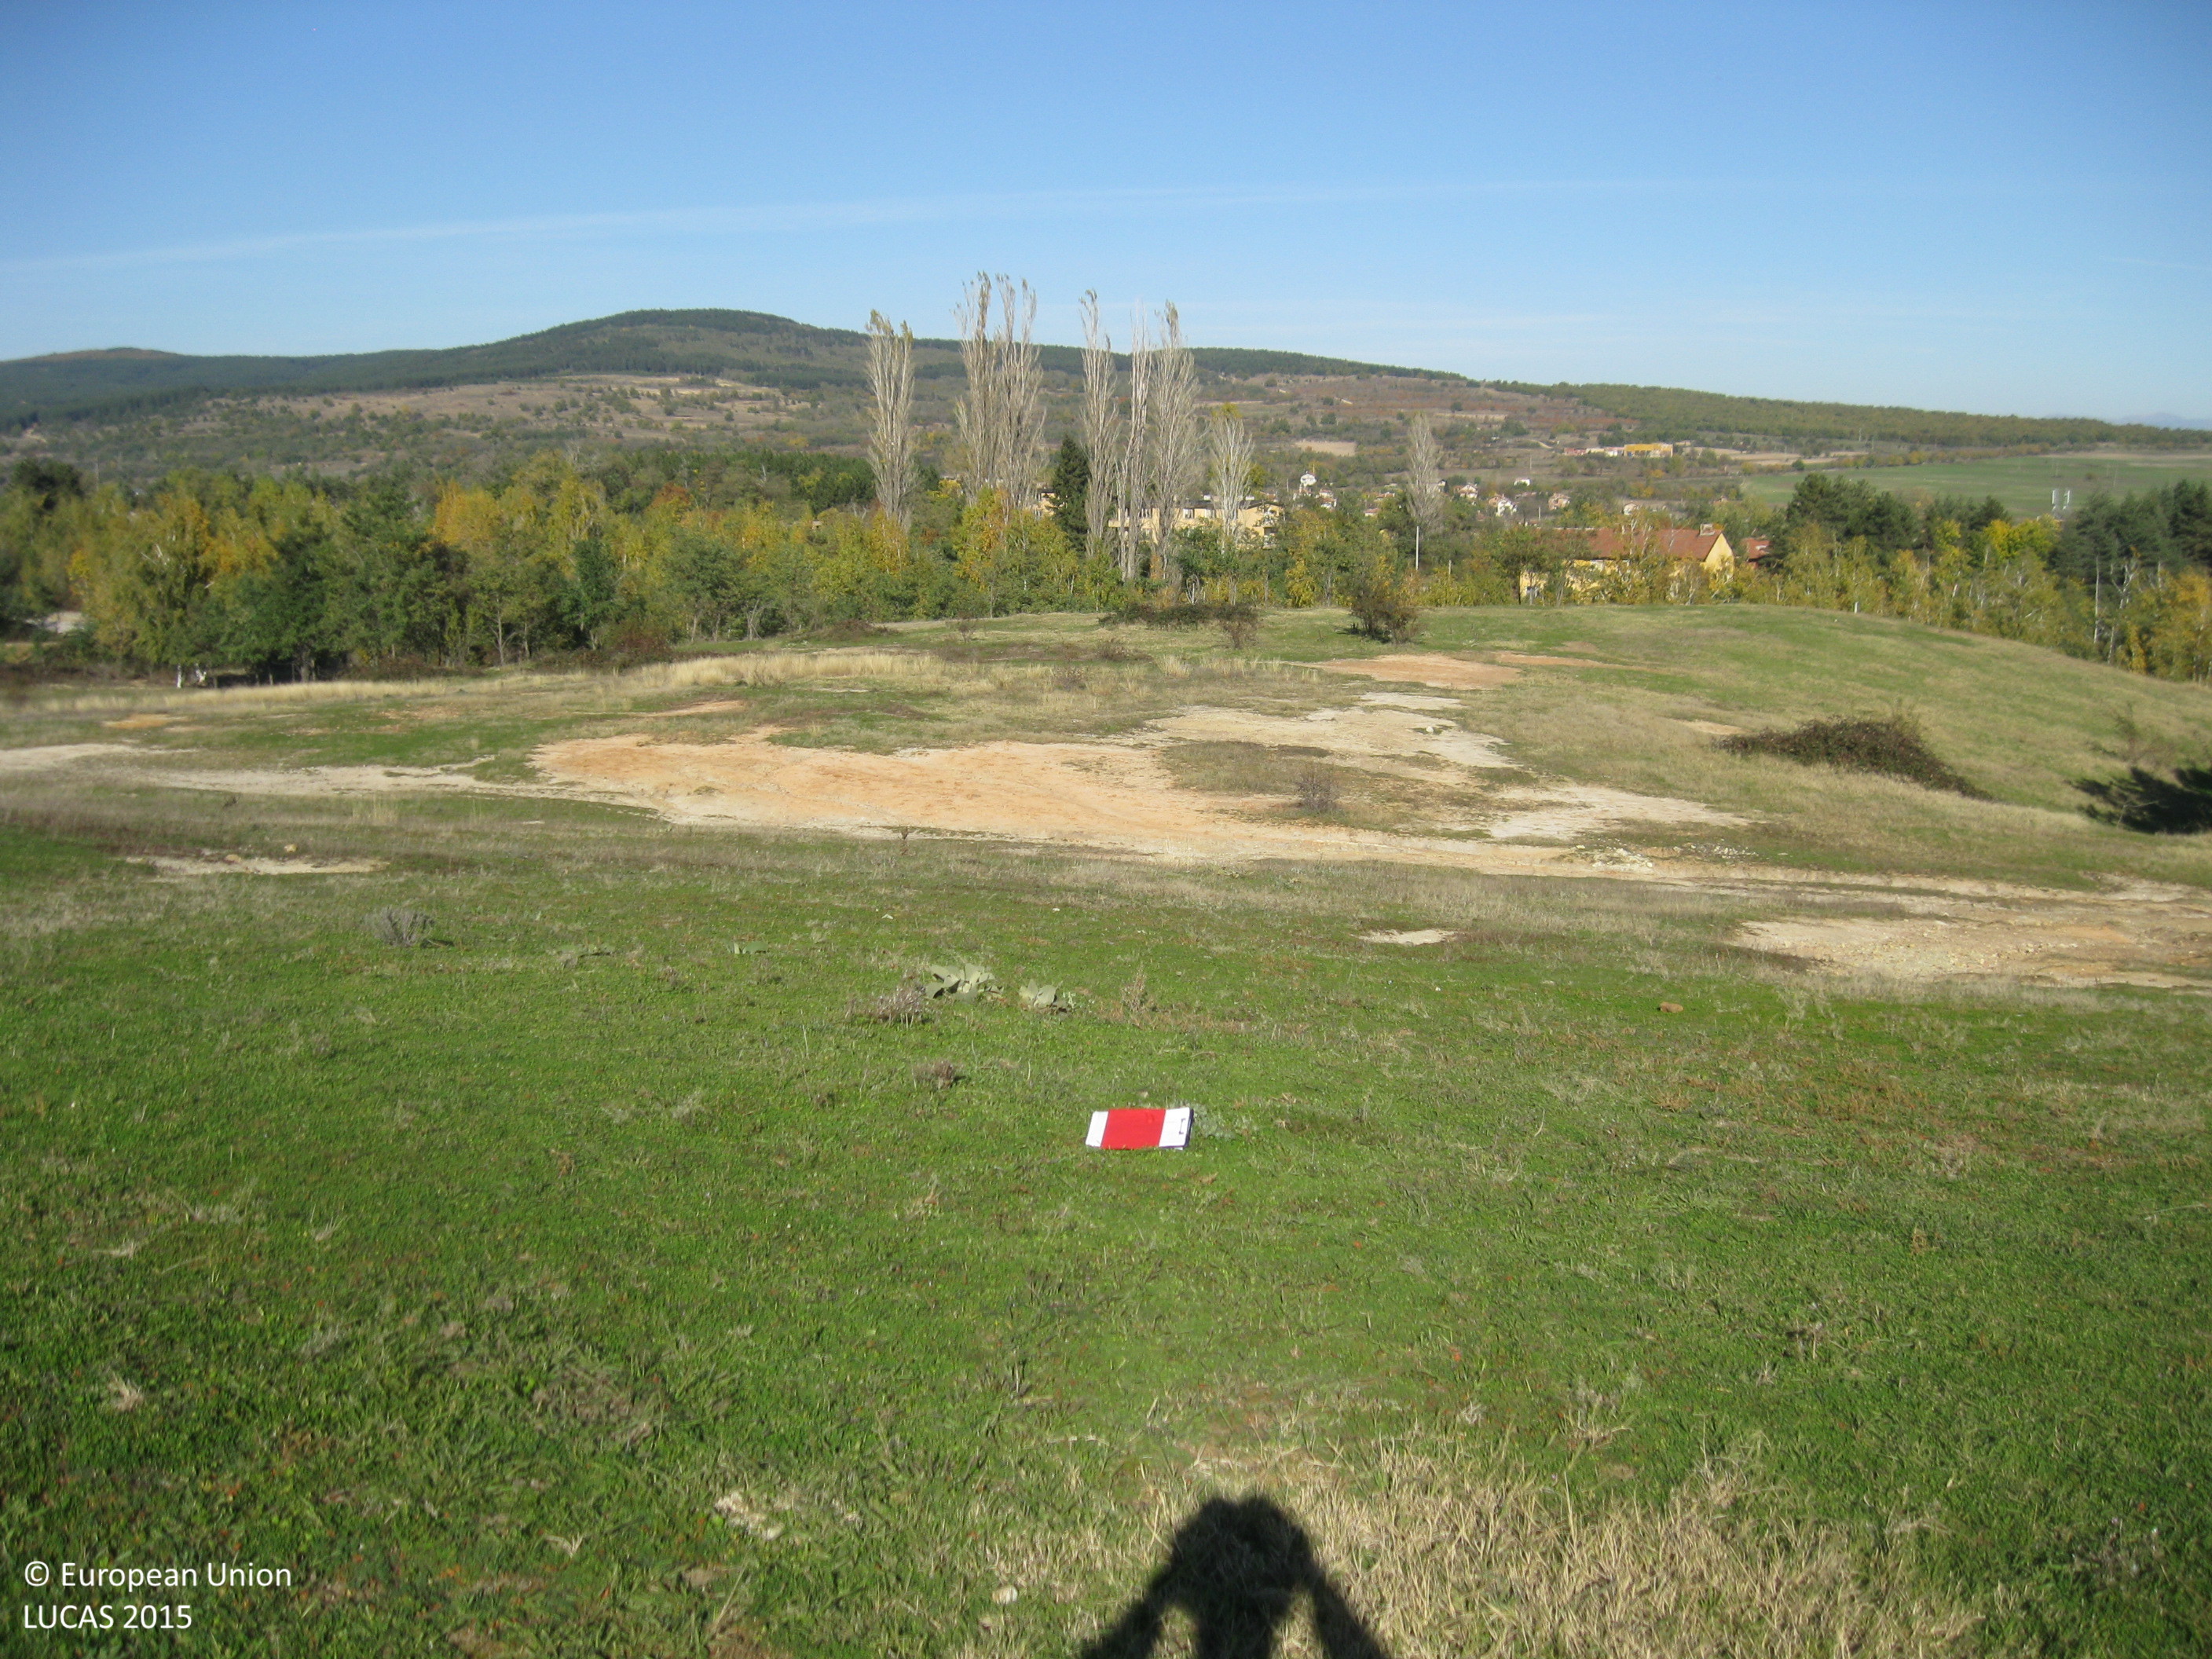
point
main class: Grassland
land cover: Grassland without tree/shrub cover
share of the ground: > 75 %
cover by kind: herbaceous plants 100 %
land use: Semi-natural and natural areas not in use
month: November
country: BG
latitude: 42.3599
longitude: 24.2137
